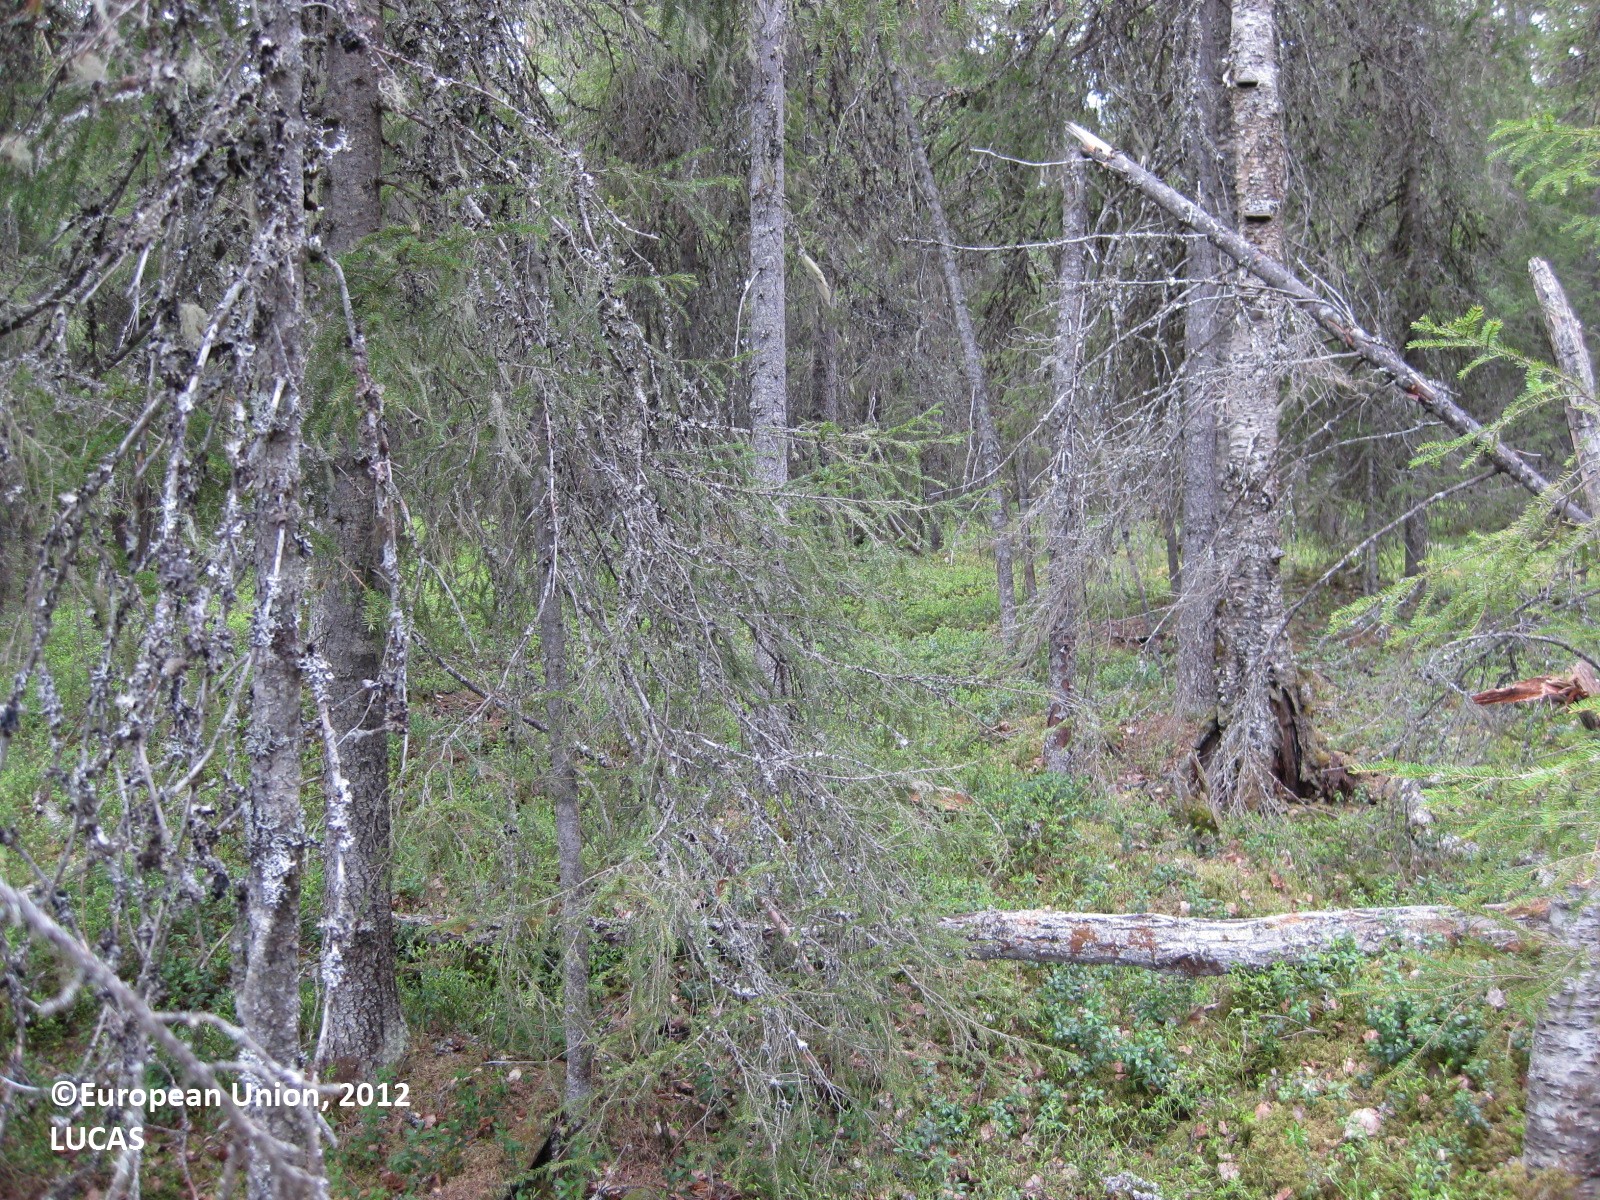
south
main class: Woodland
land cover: Spruce dominated coniferous woodland
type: boreal forest
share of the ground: > 75 %
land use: Forestry
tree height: > 5 m
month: June
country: FI
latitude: 65.3253
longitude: 29.1882
